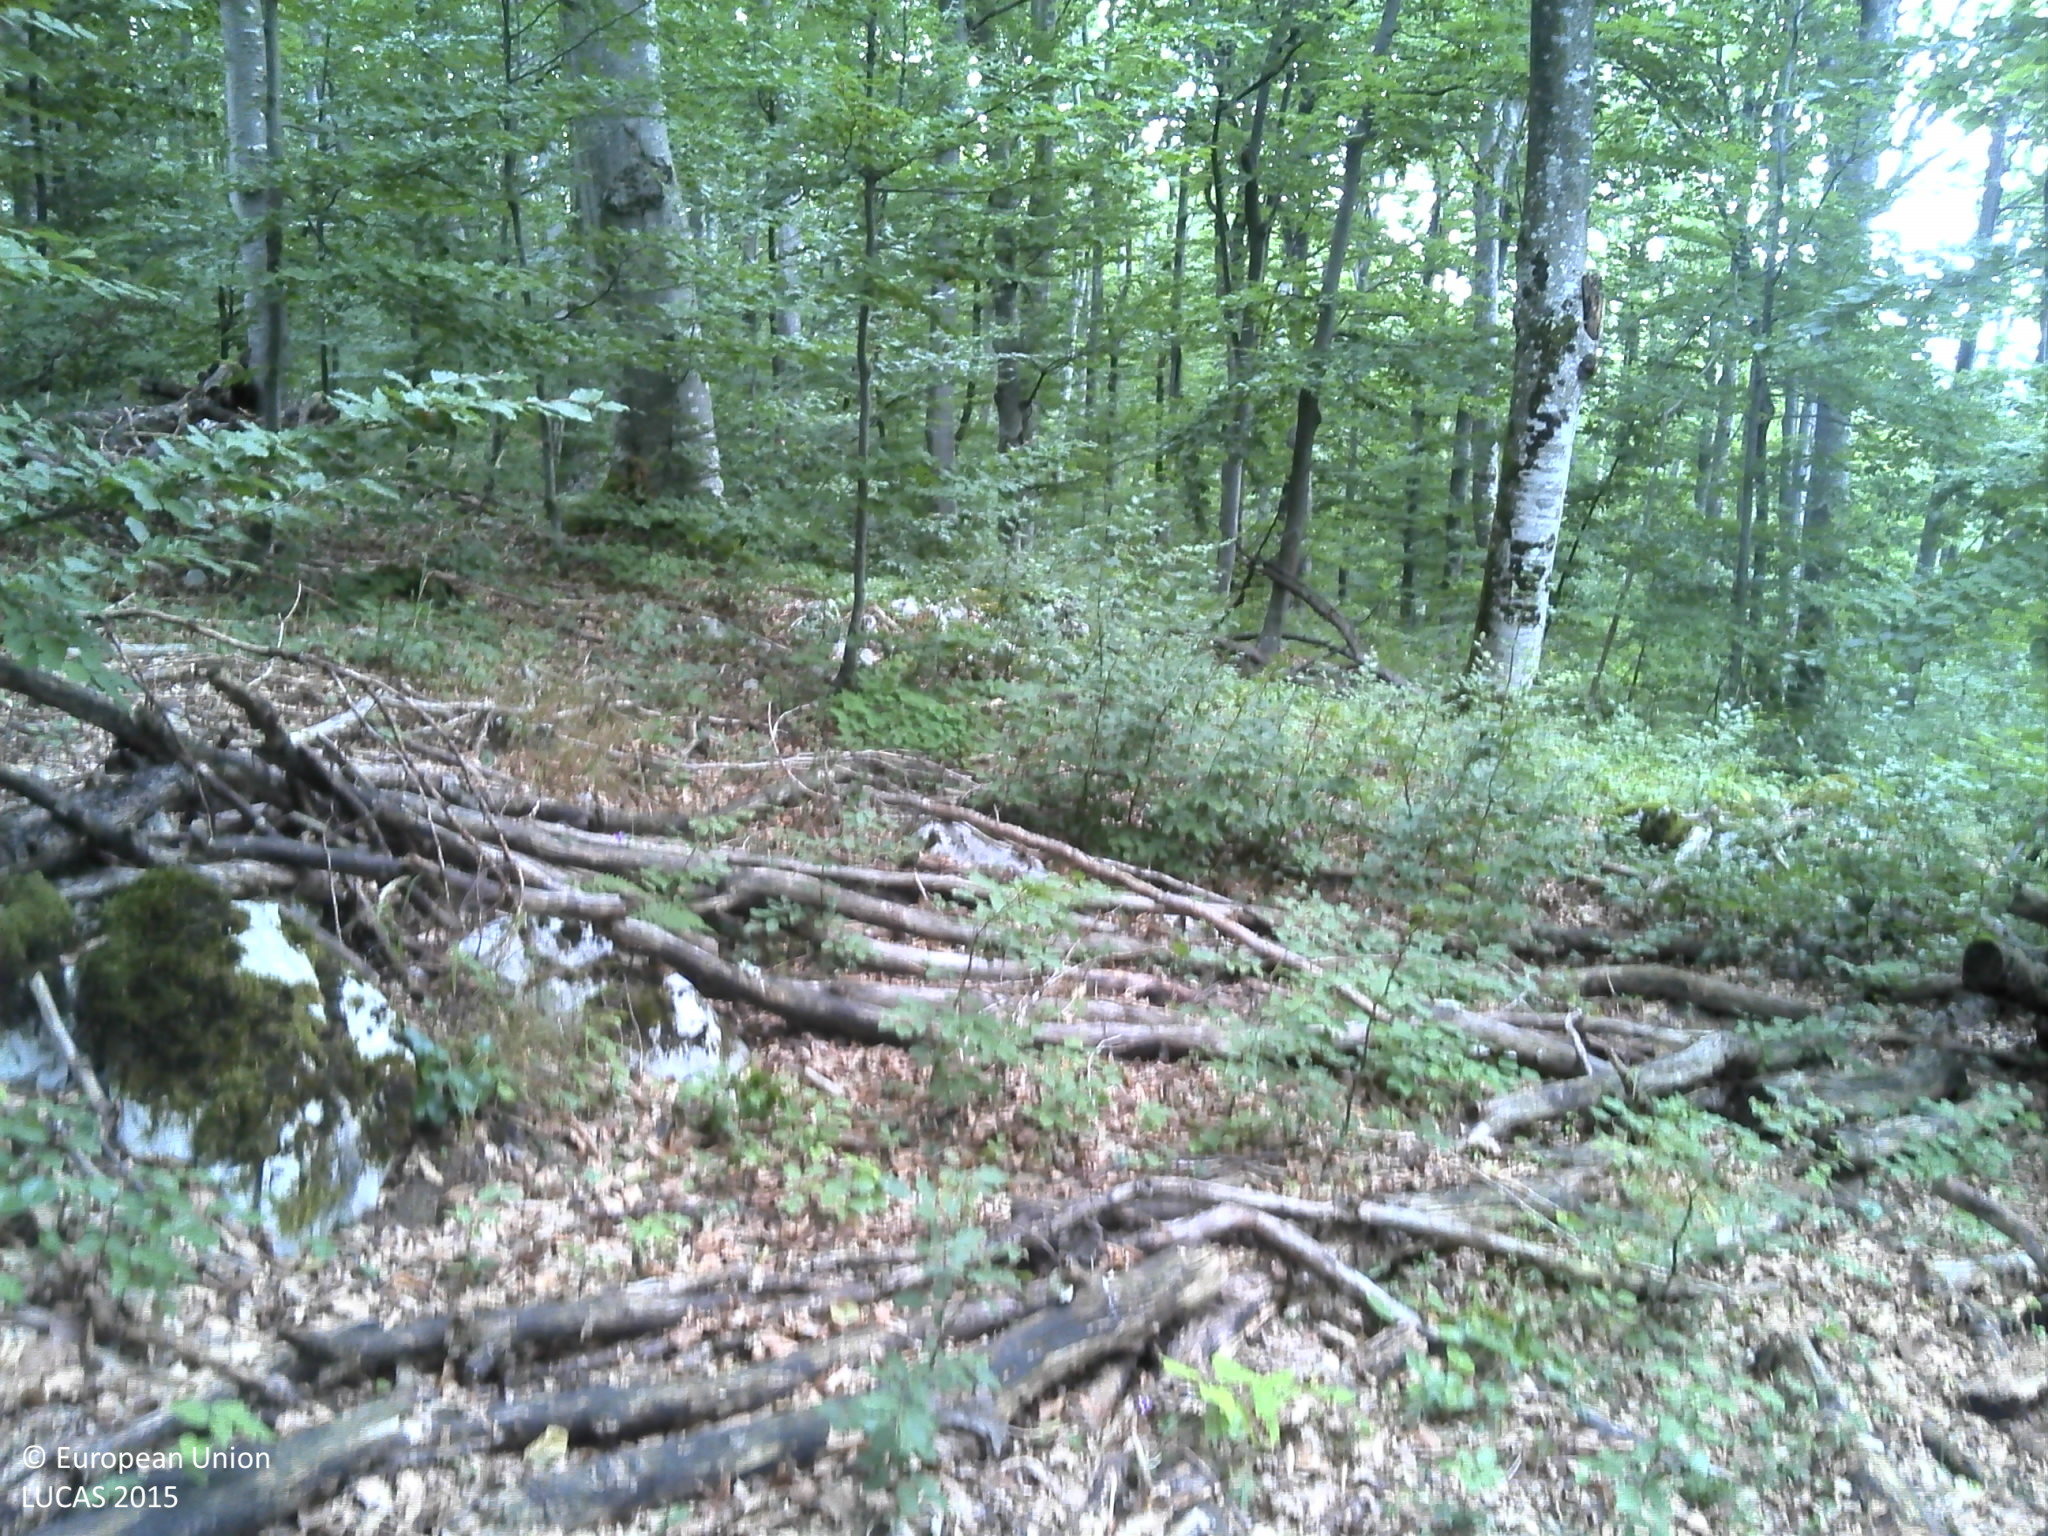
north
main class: Woodland
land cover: Broadleaved woodland
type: beech forest
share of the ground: > 75 %
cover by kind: broadleaved forest trees 100 %
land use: Forestry
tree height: > 5 m
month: September
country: HR
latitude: 45.3574
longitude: 15.2166
